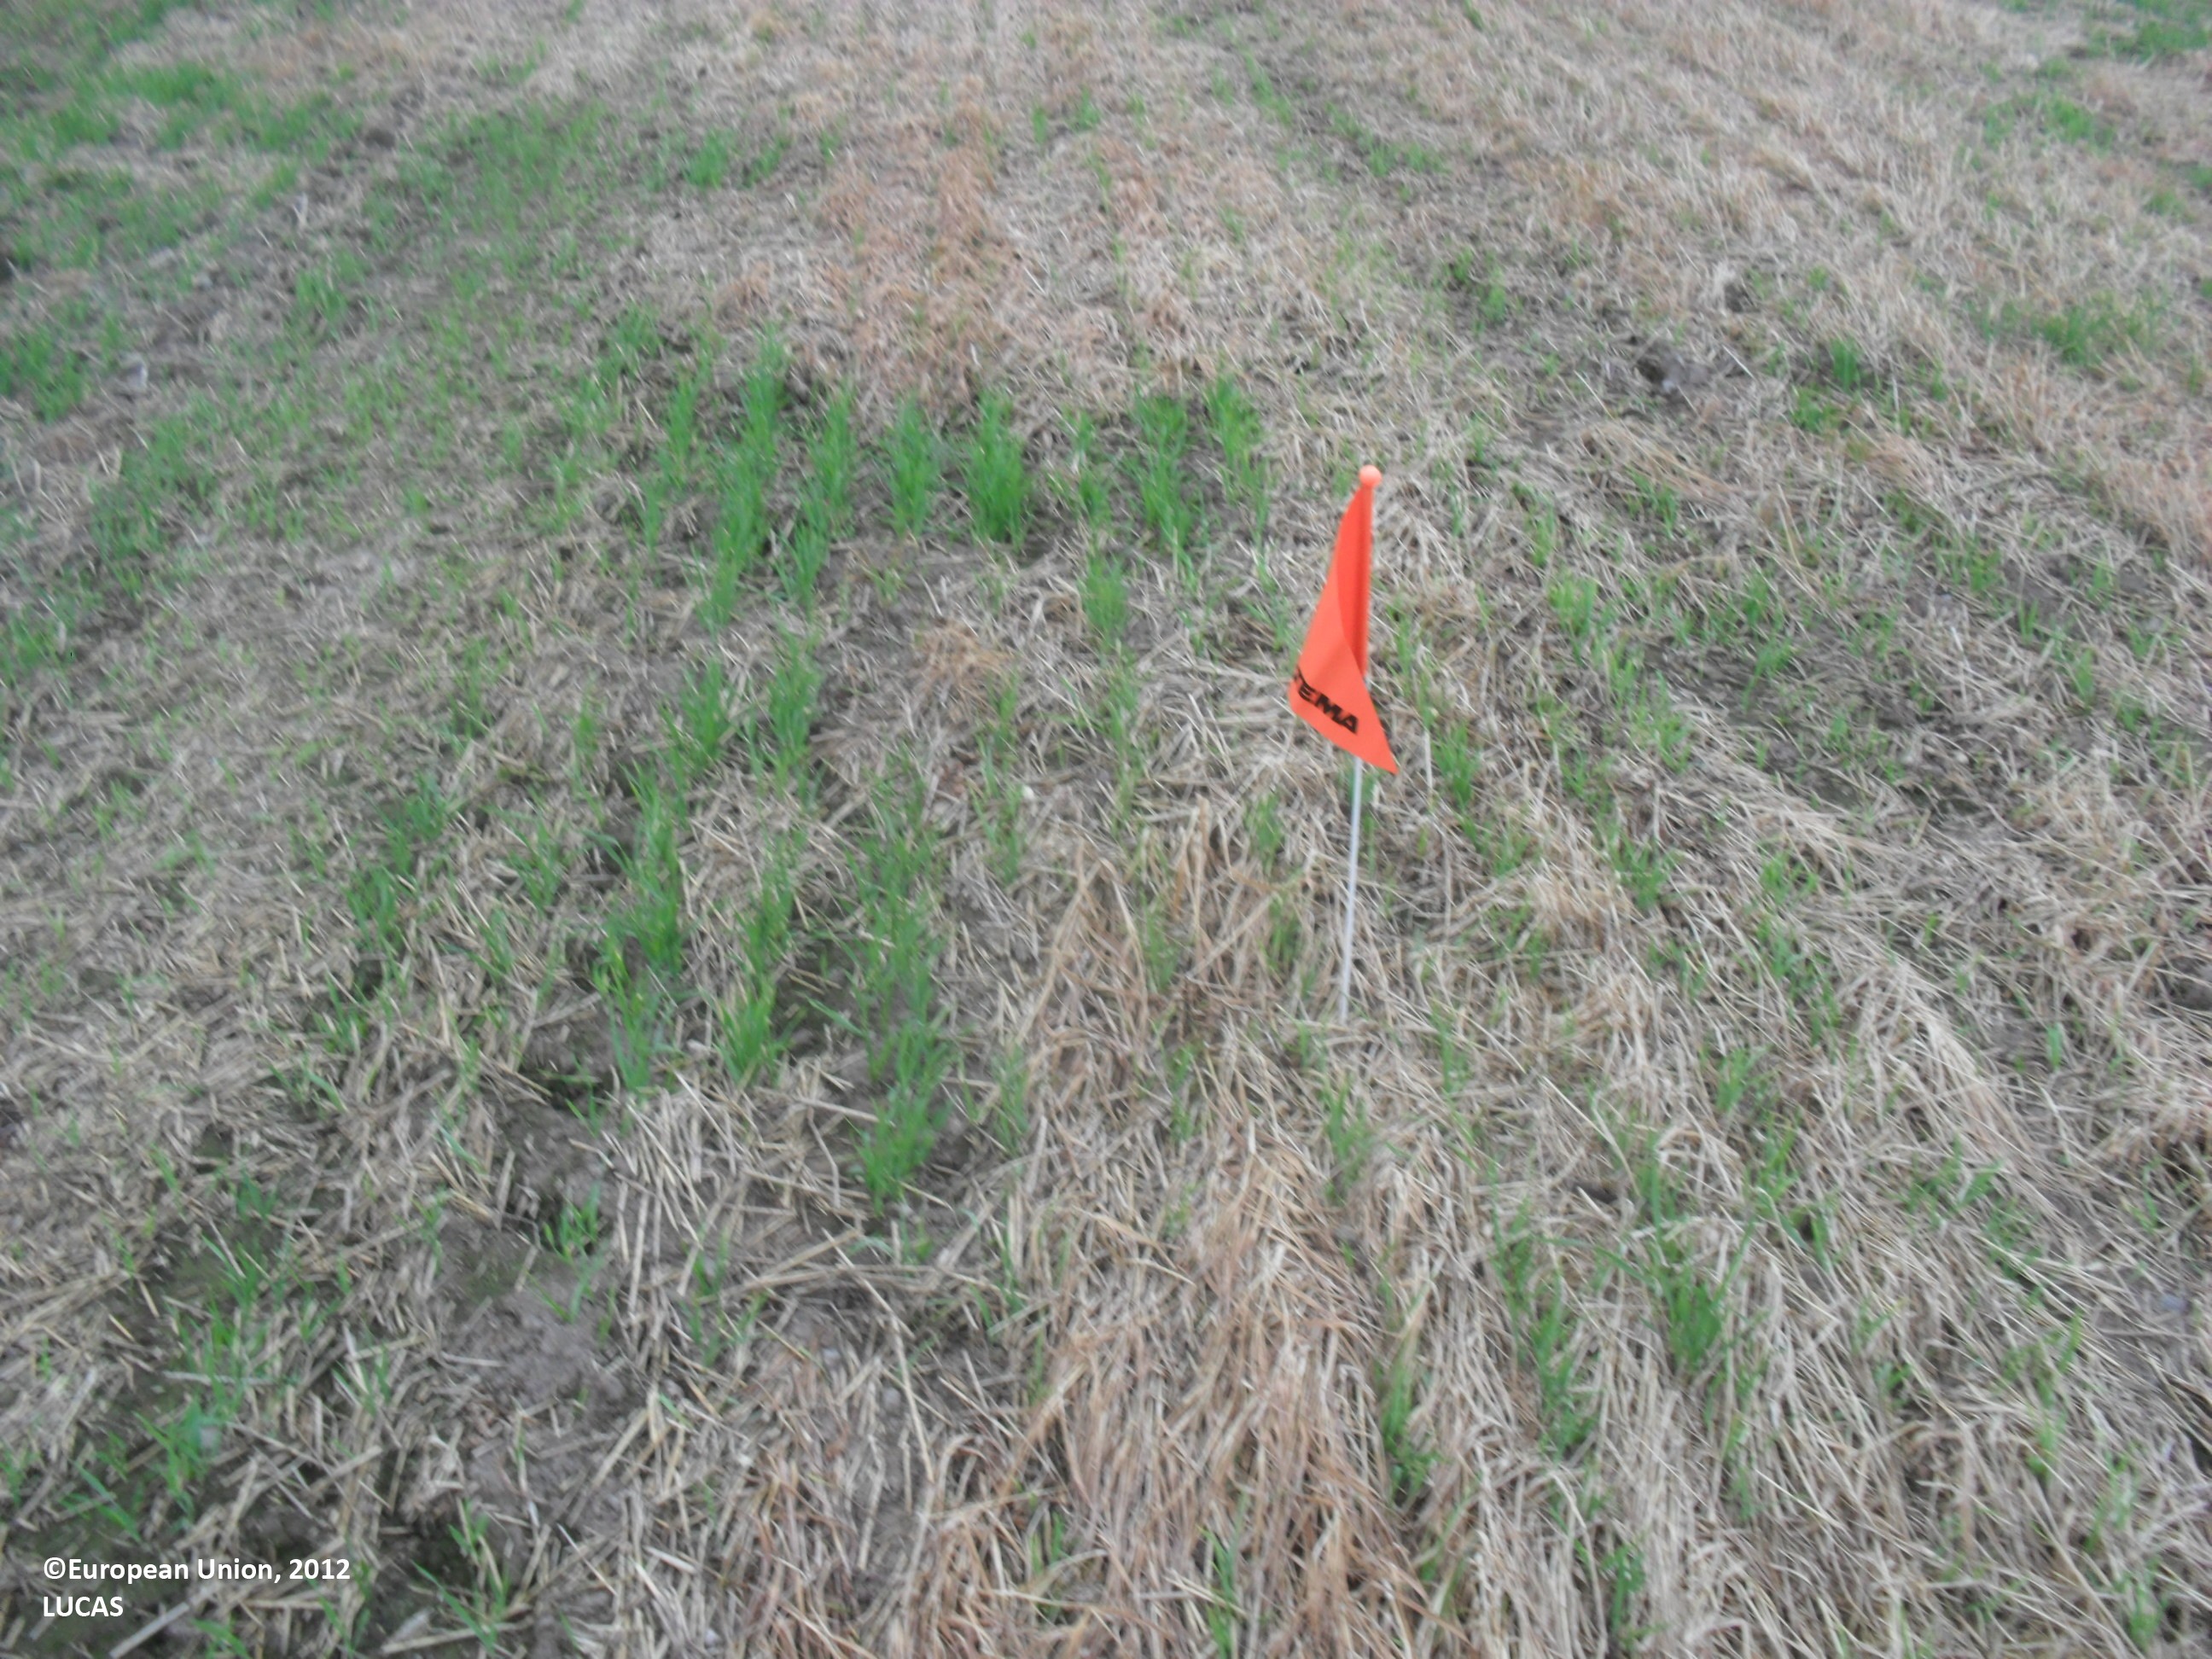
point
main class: Cropland
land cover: Barley
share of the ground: < 10 %
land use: Agriculture (excluding fallow land and kitchen gardens)
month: June
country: FI
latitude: 63.3216
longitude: 23.2962
